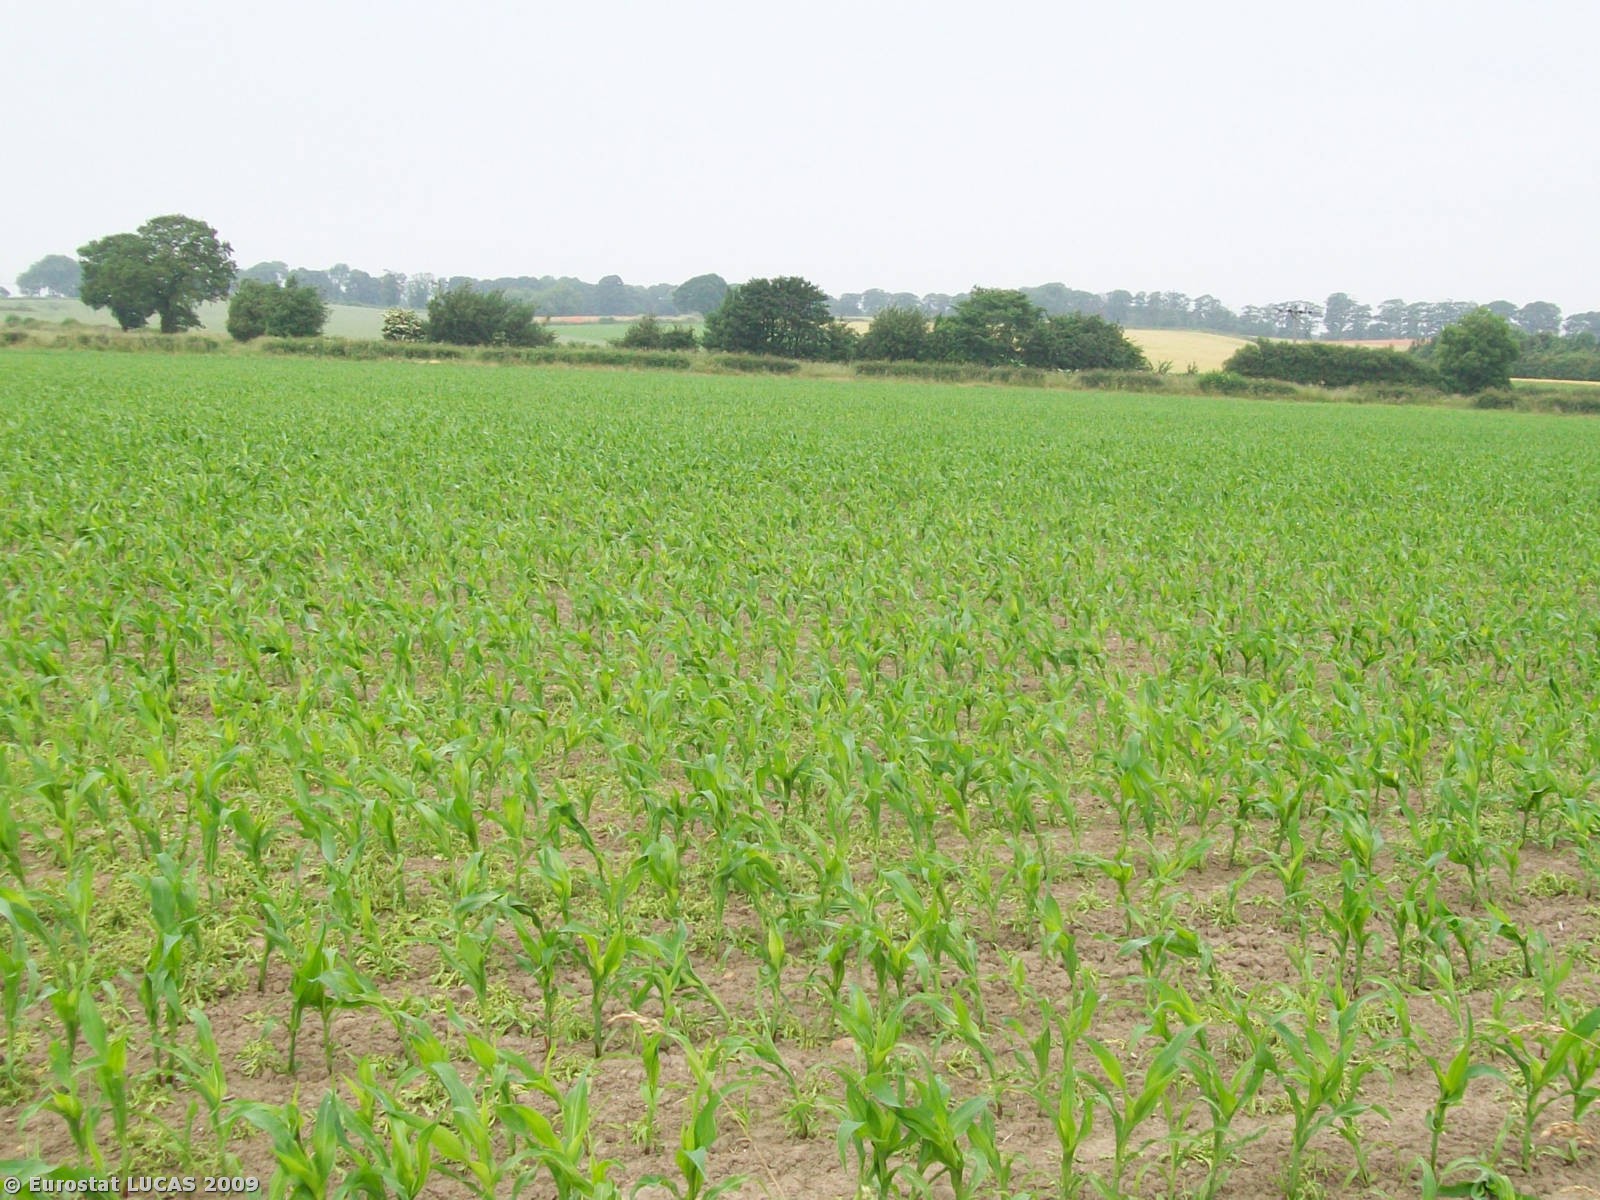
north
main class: Grassland
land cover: Grassland without tree/shrub cover
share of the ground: < 10 %
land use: Agriculture (excluding fallow land and kitchen gardens)
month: June
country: GB
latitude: 54.0401
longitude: -1.4246
